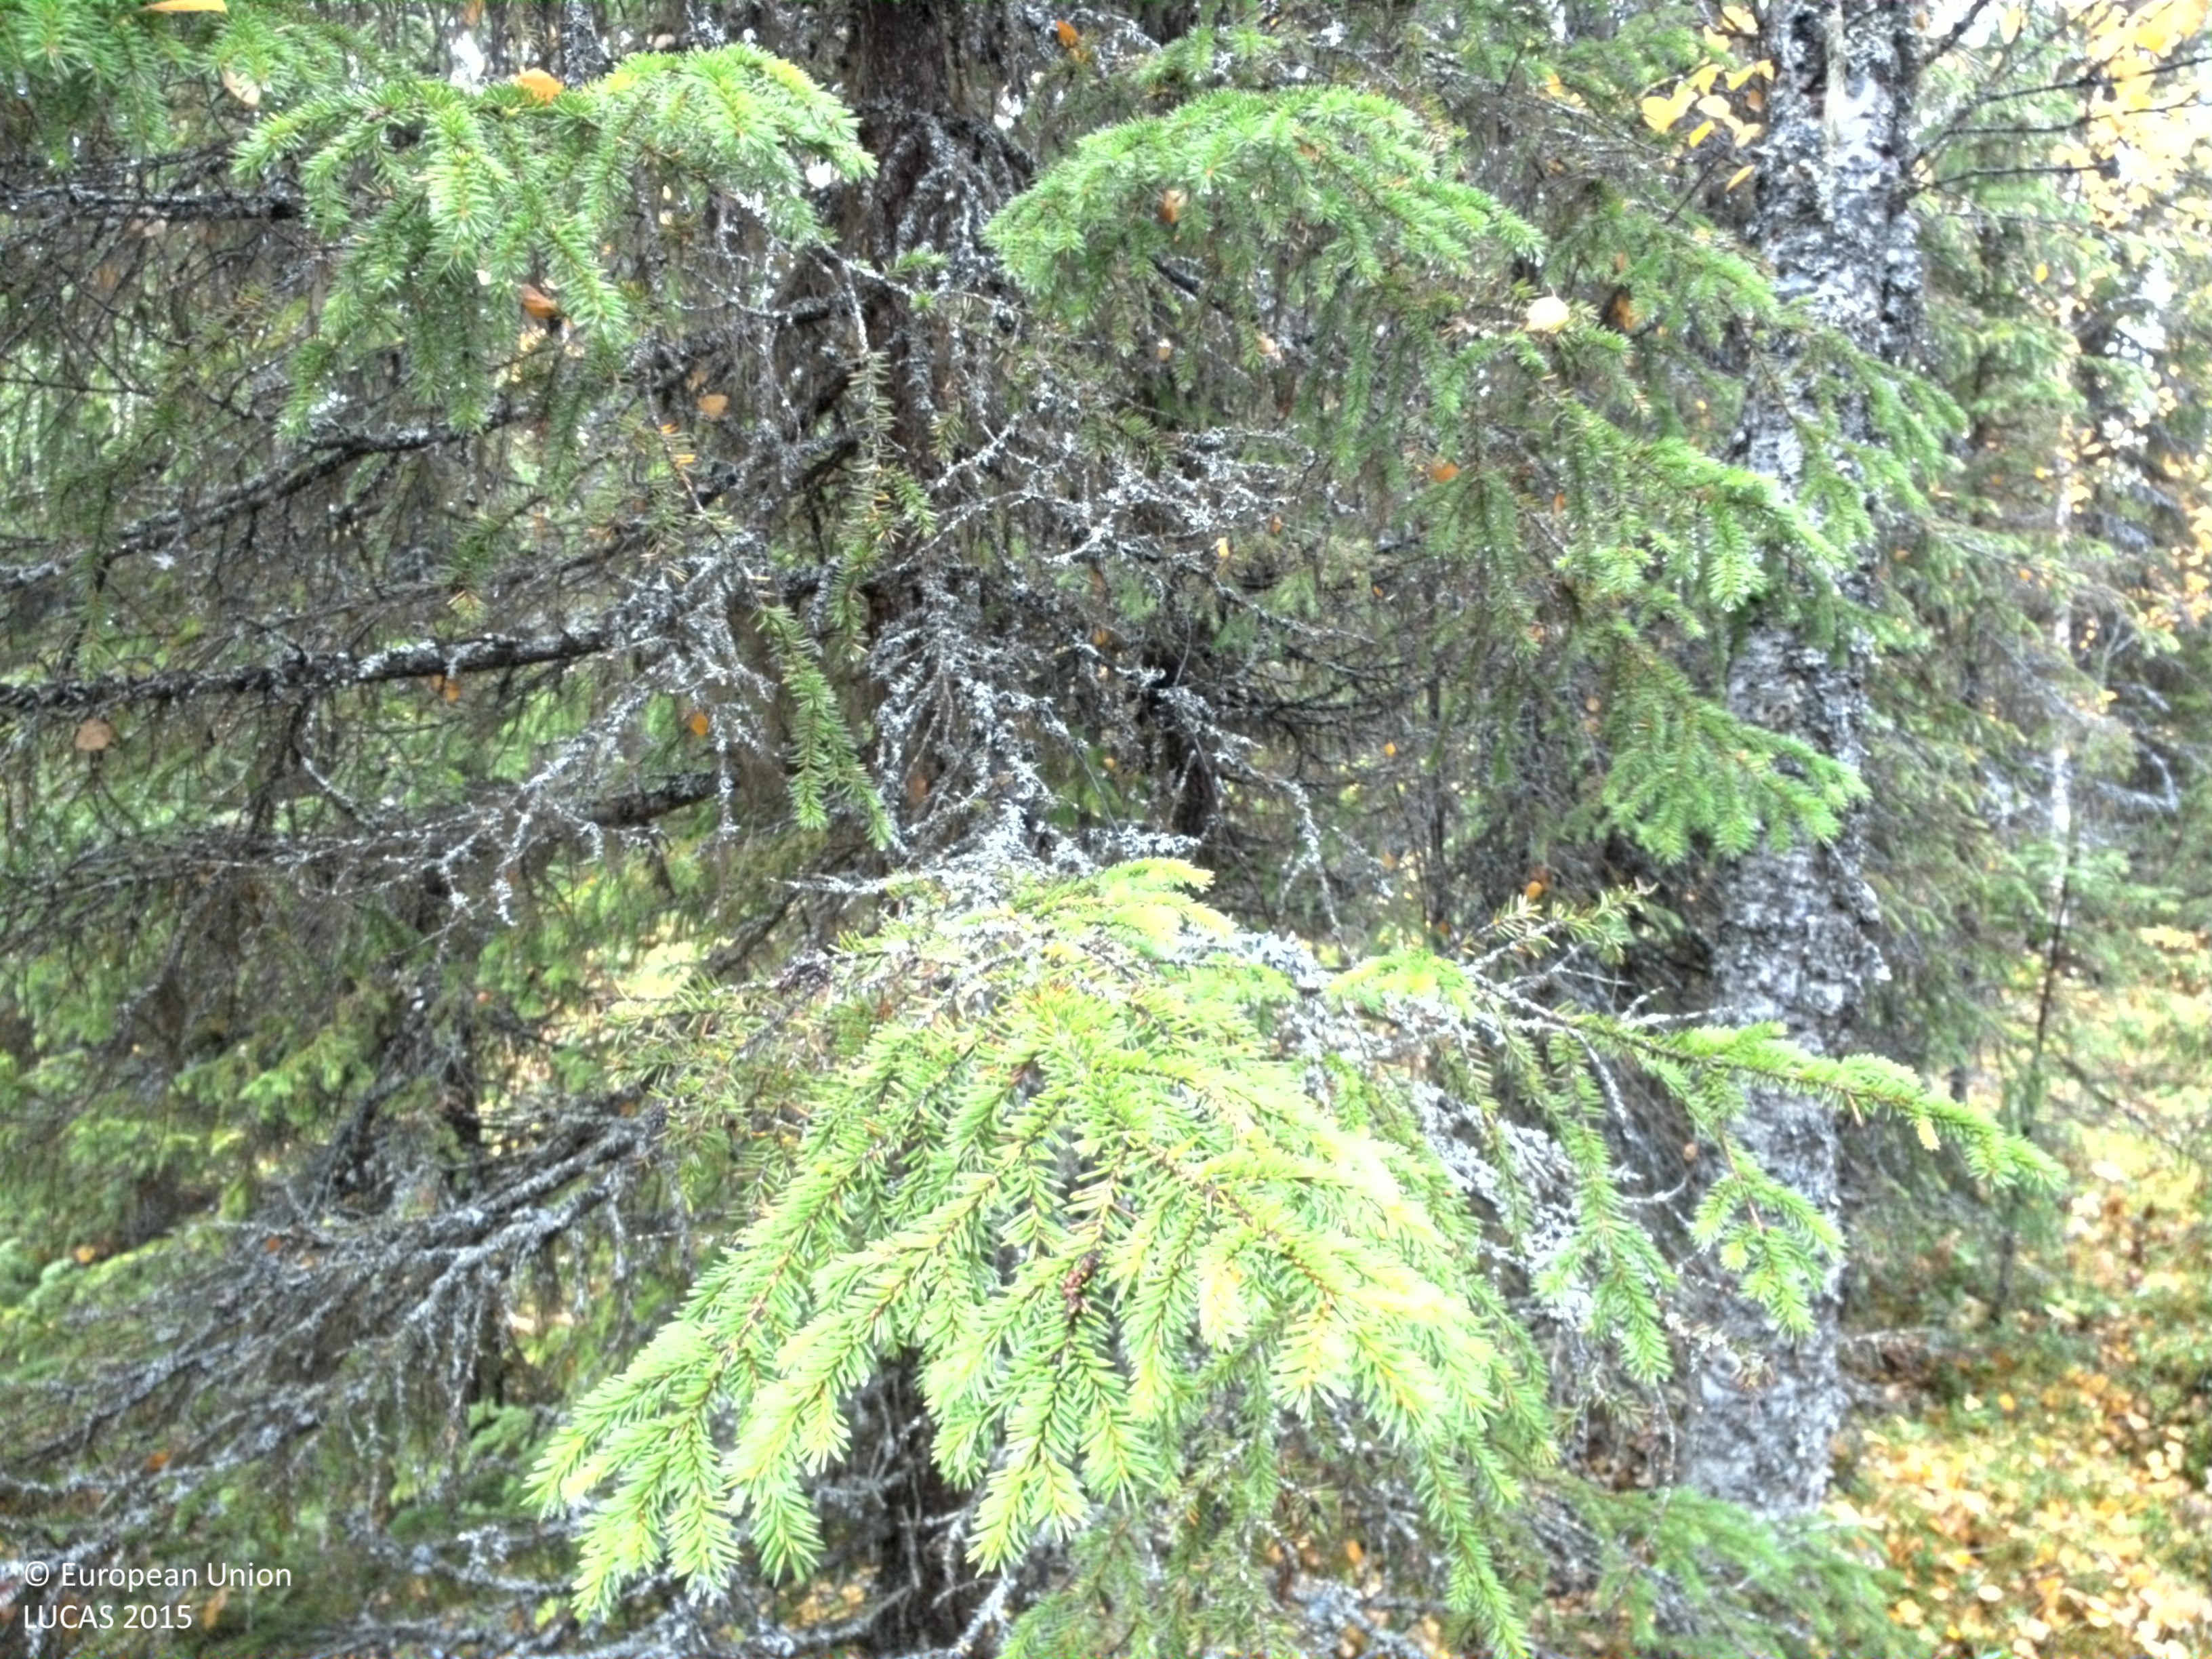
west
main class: Woodland
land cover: Spruce dominated mixed woodland
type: boreal forest
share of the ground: 25 - 50 %
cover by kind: coniferous forest trees 30 %, shrubs 20 %, herbaceous plants 20 %, lichens and mosses 20 %, broadleaved forest trees 10 %
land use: Forestry
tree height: > 5 m
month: September
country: SE
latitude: 65.2544
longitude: 16.2369
